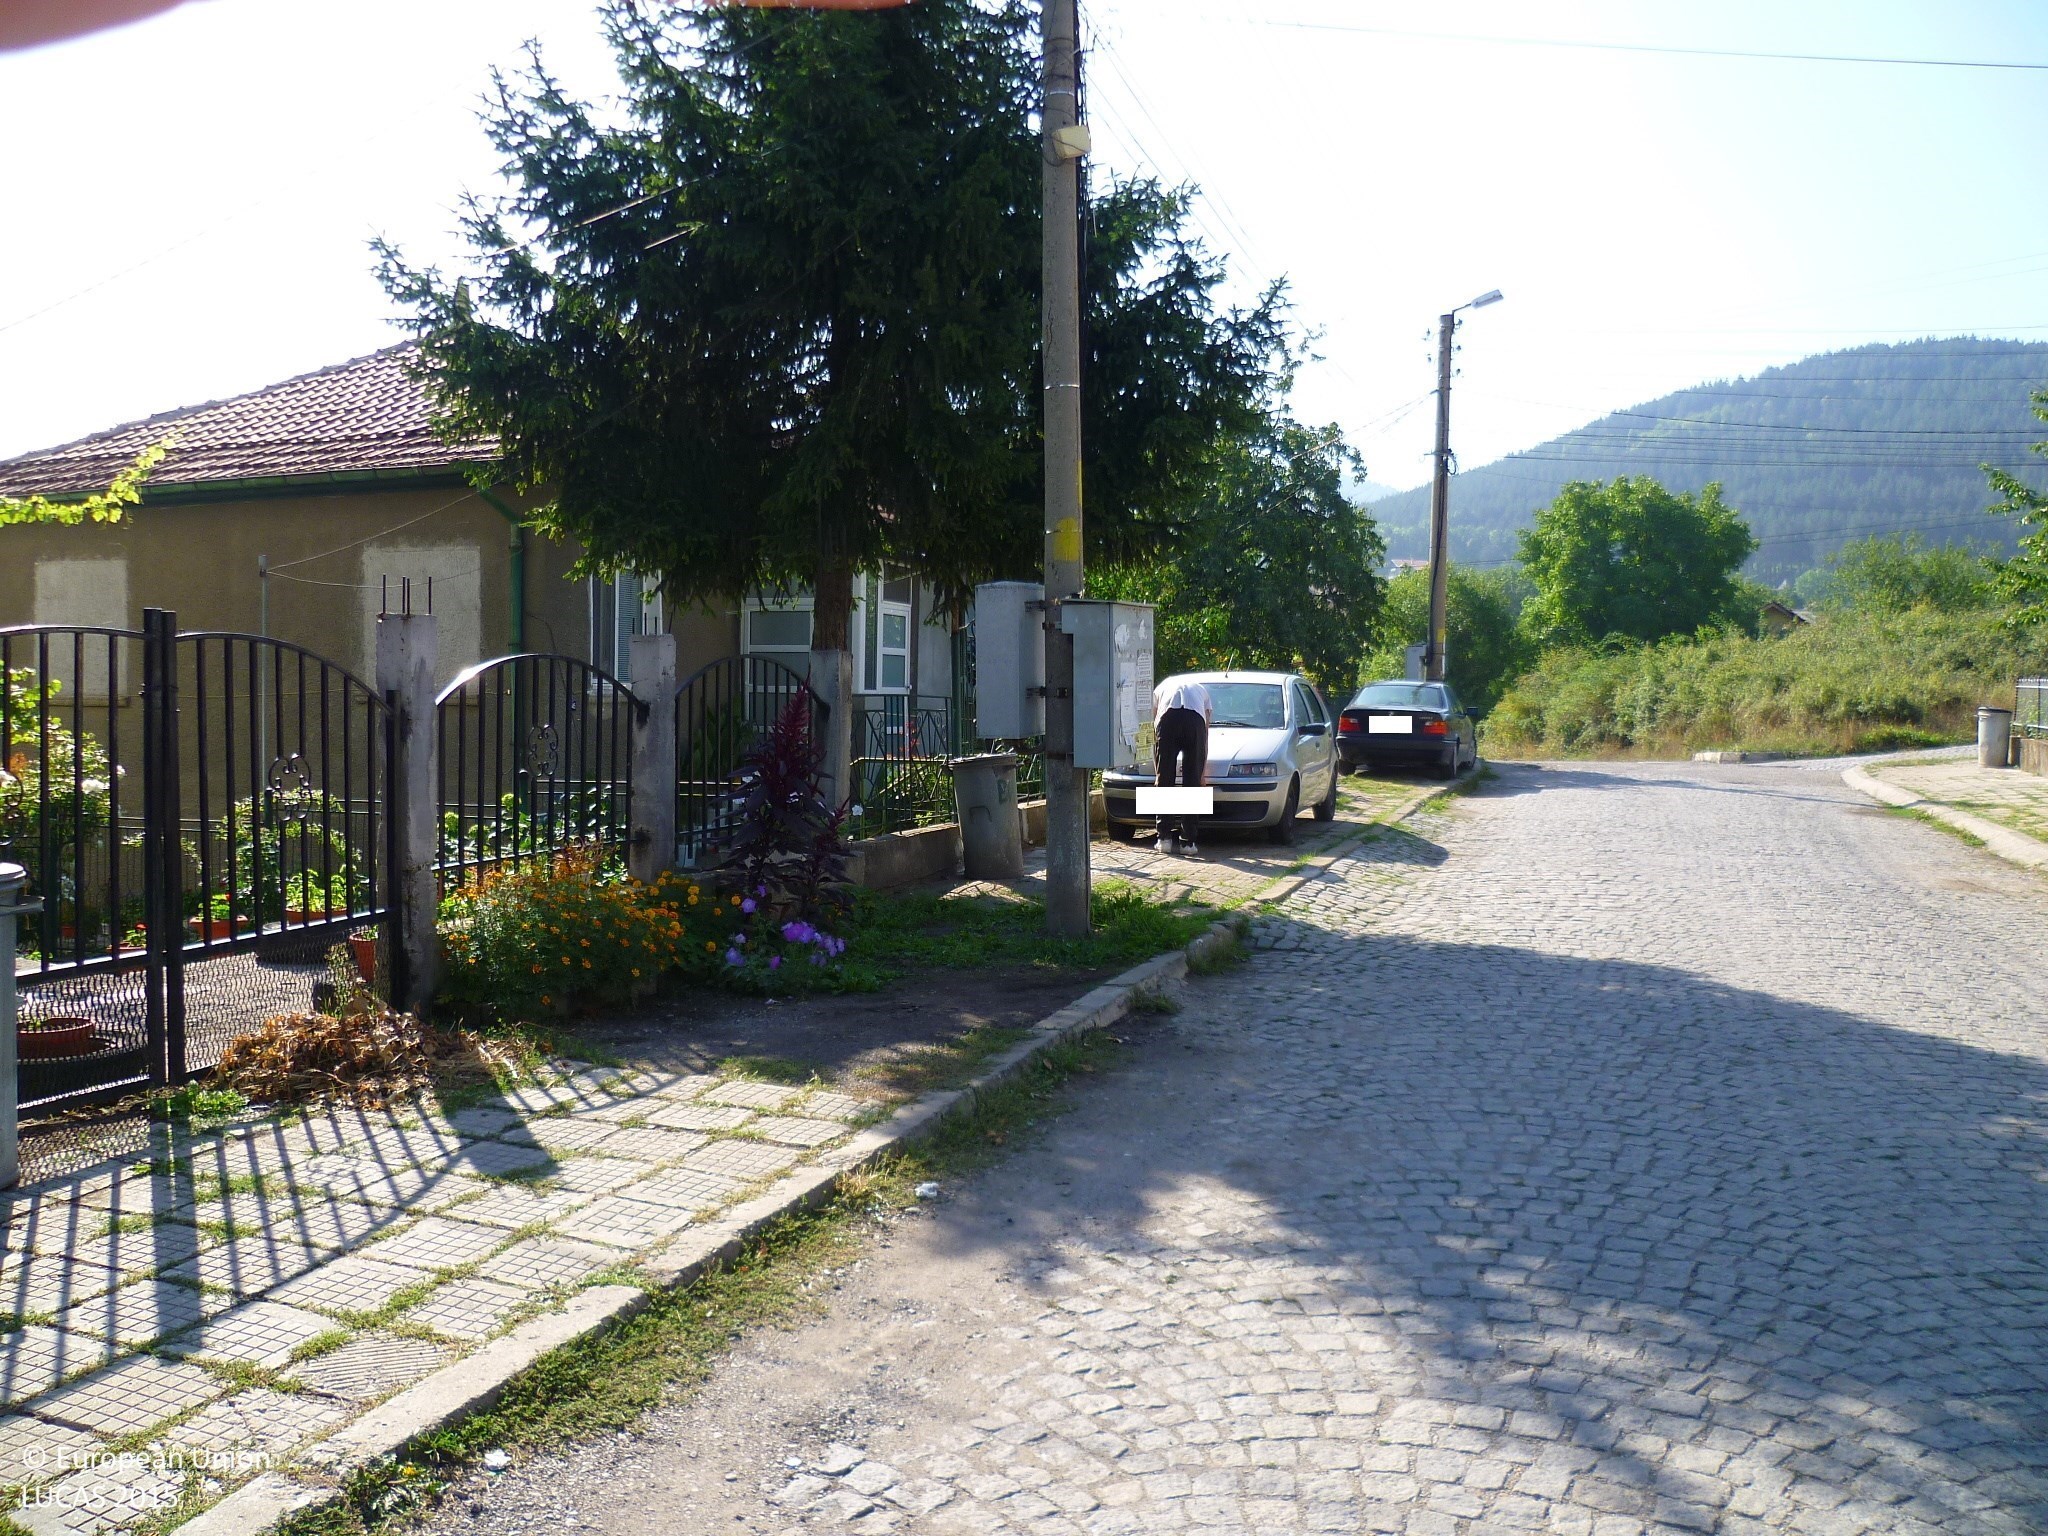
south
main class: Woodland
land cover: Broadleaved woodland
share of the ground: > 75 %
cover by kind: broadleaved forest trees 100 %
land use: Residential
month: September
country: BG
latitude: 42.5936
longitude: 23.0324
